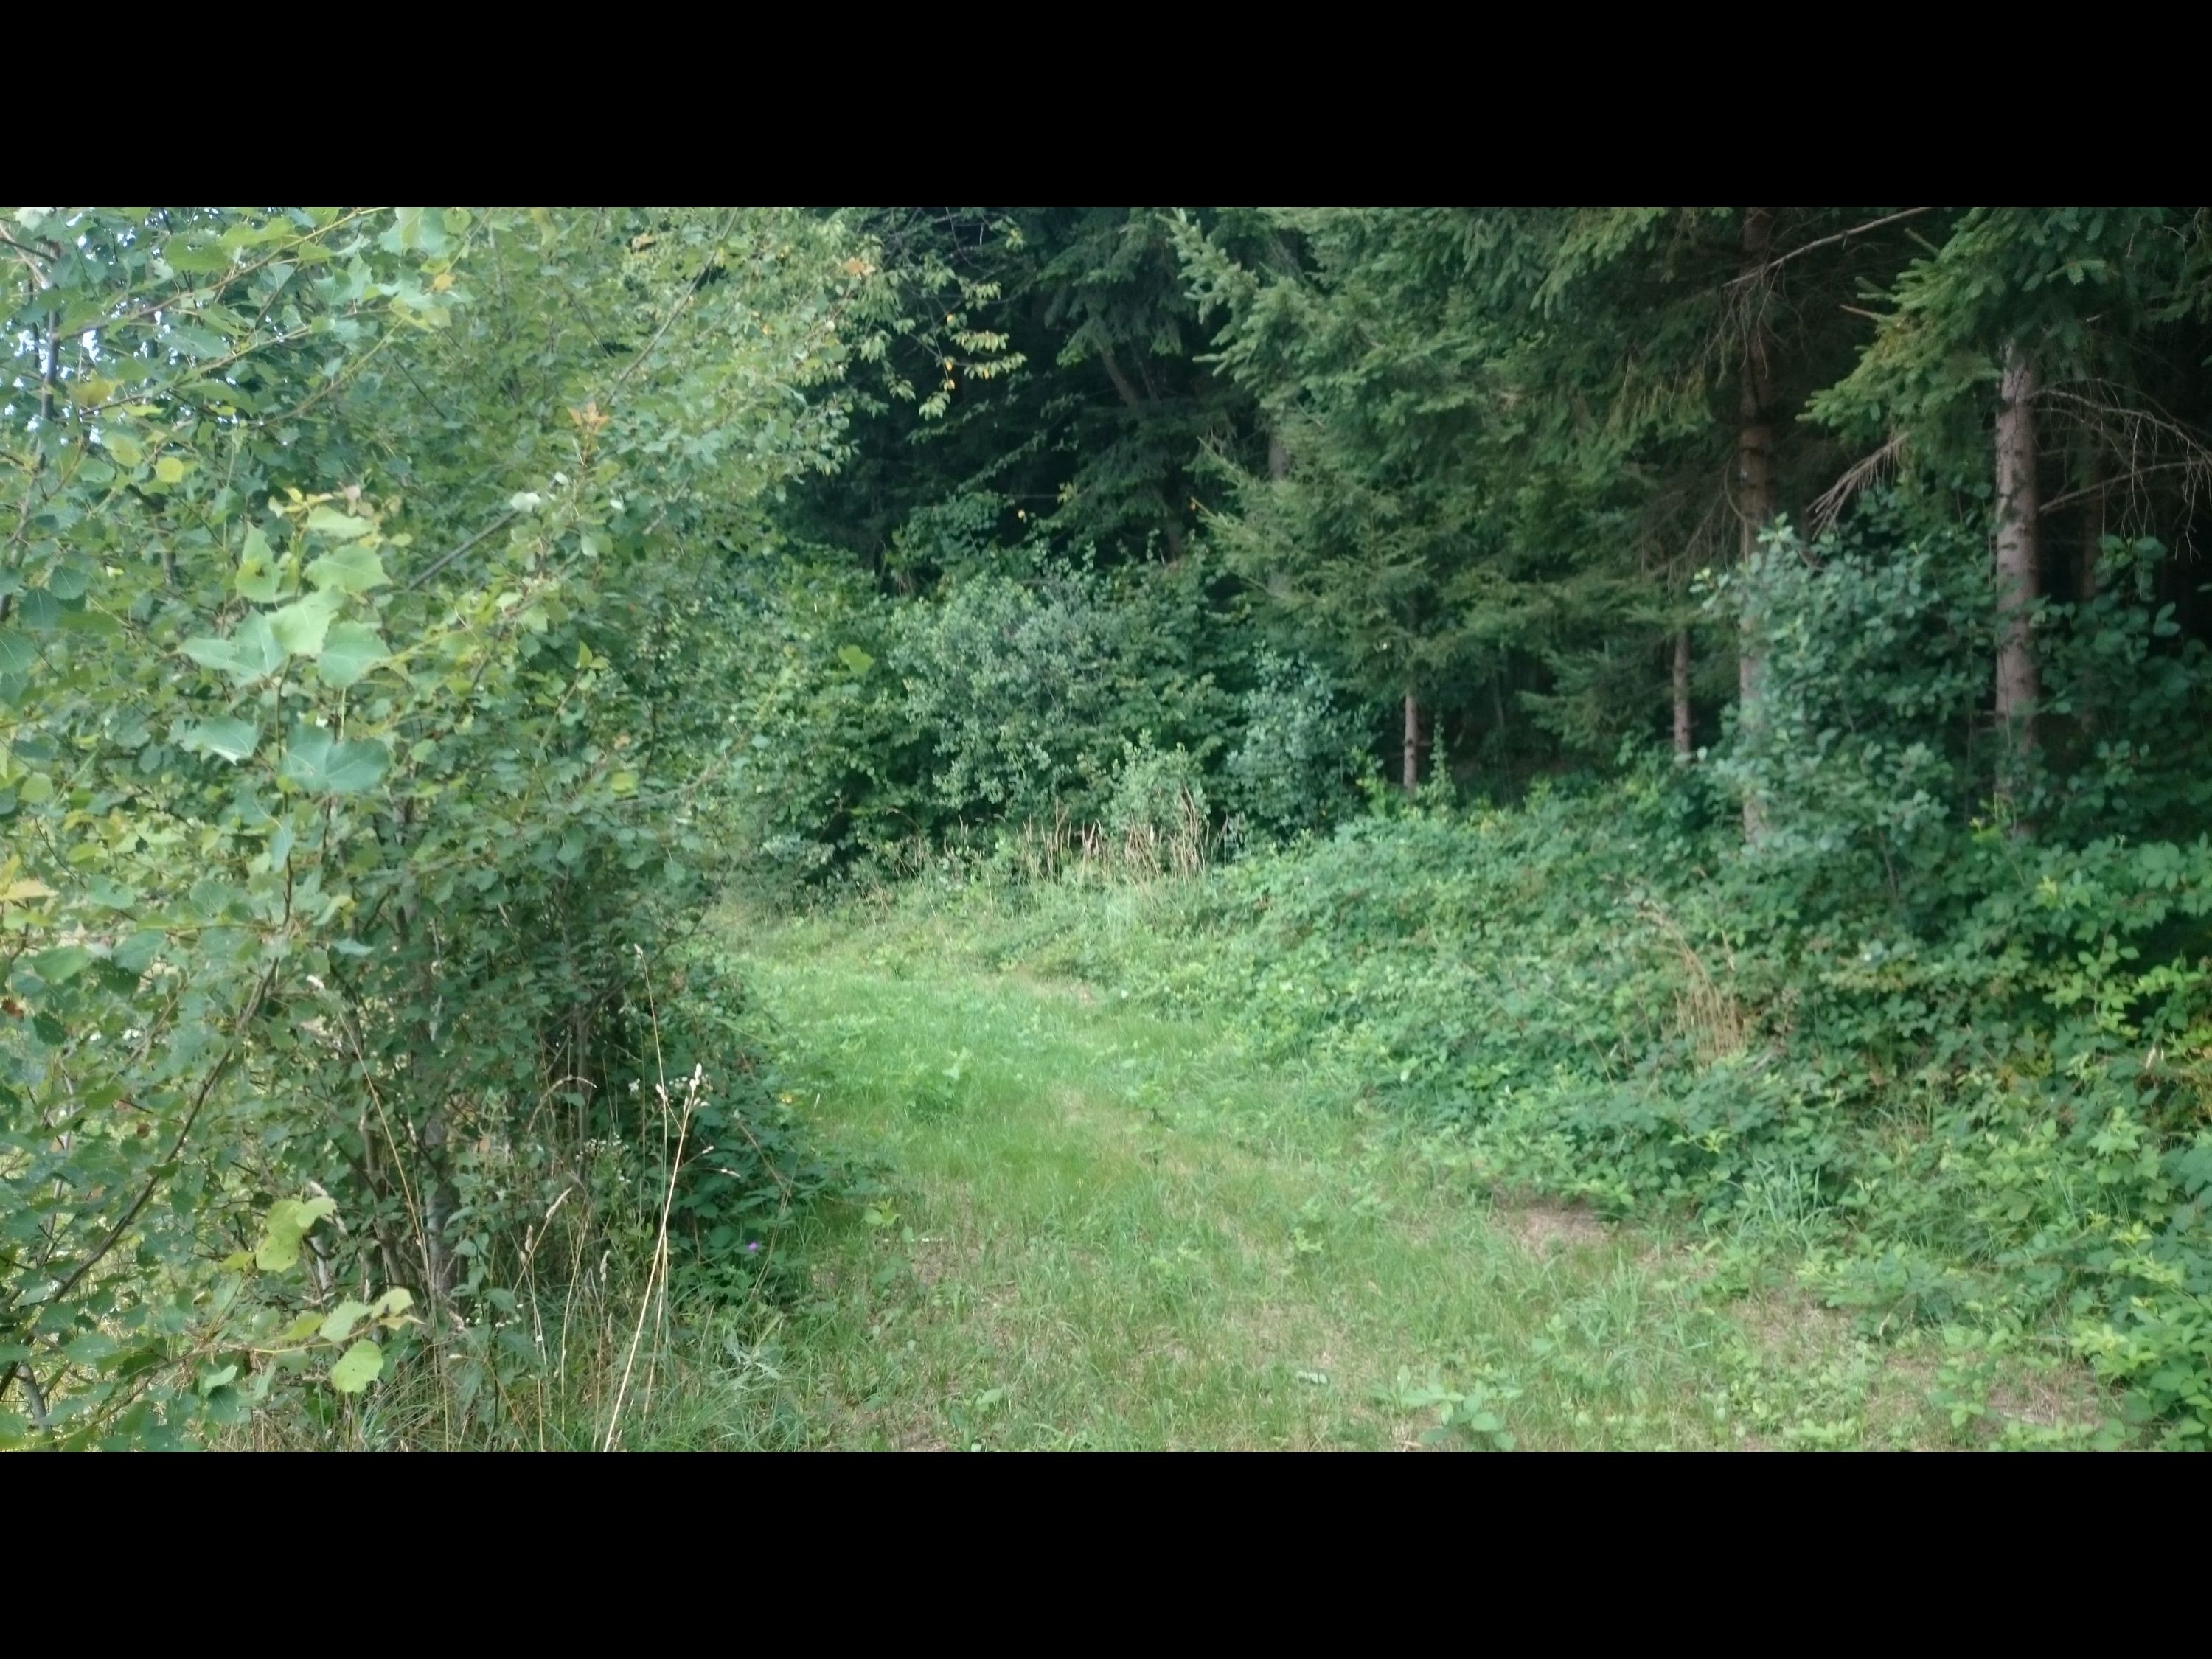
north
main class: Grassland
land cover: Grassland without tree/shrub cover
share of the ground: > 75 %
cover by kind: herbaceous plants 100 %
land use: Agriculture (excluding fallow land and kitchen gardens)
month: July
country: AT
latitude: 46.9617
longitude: 15.9540
